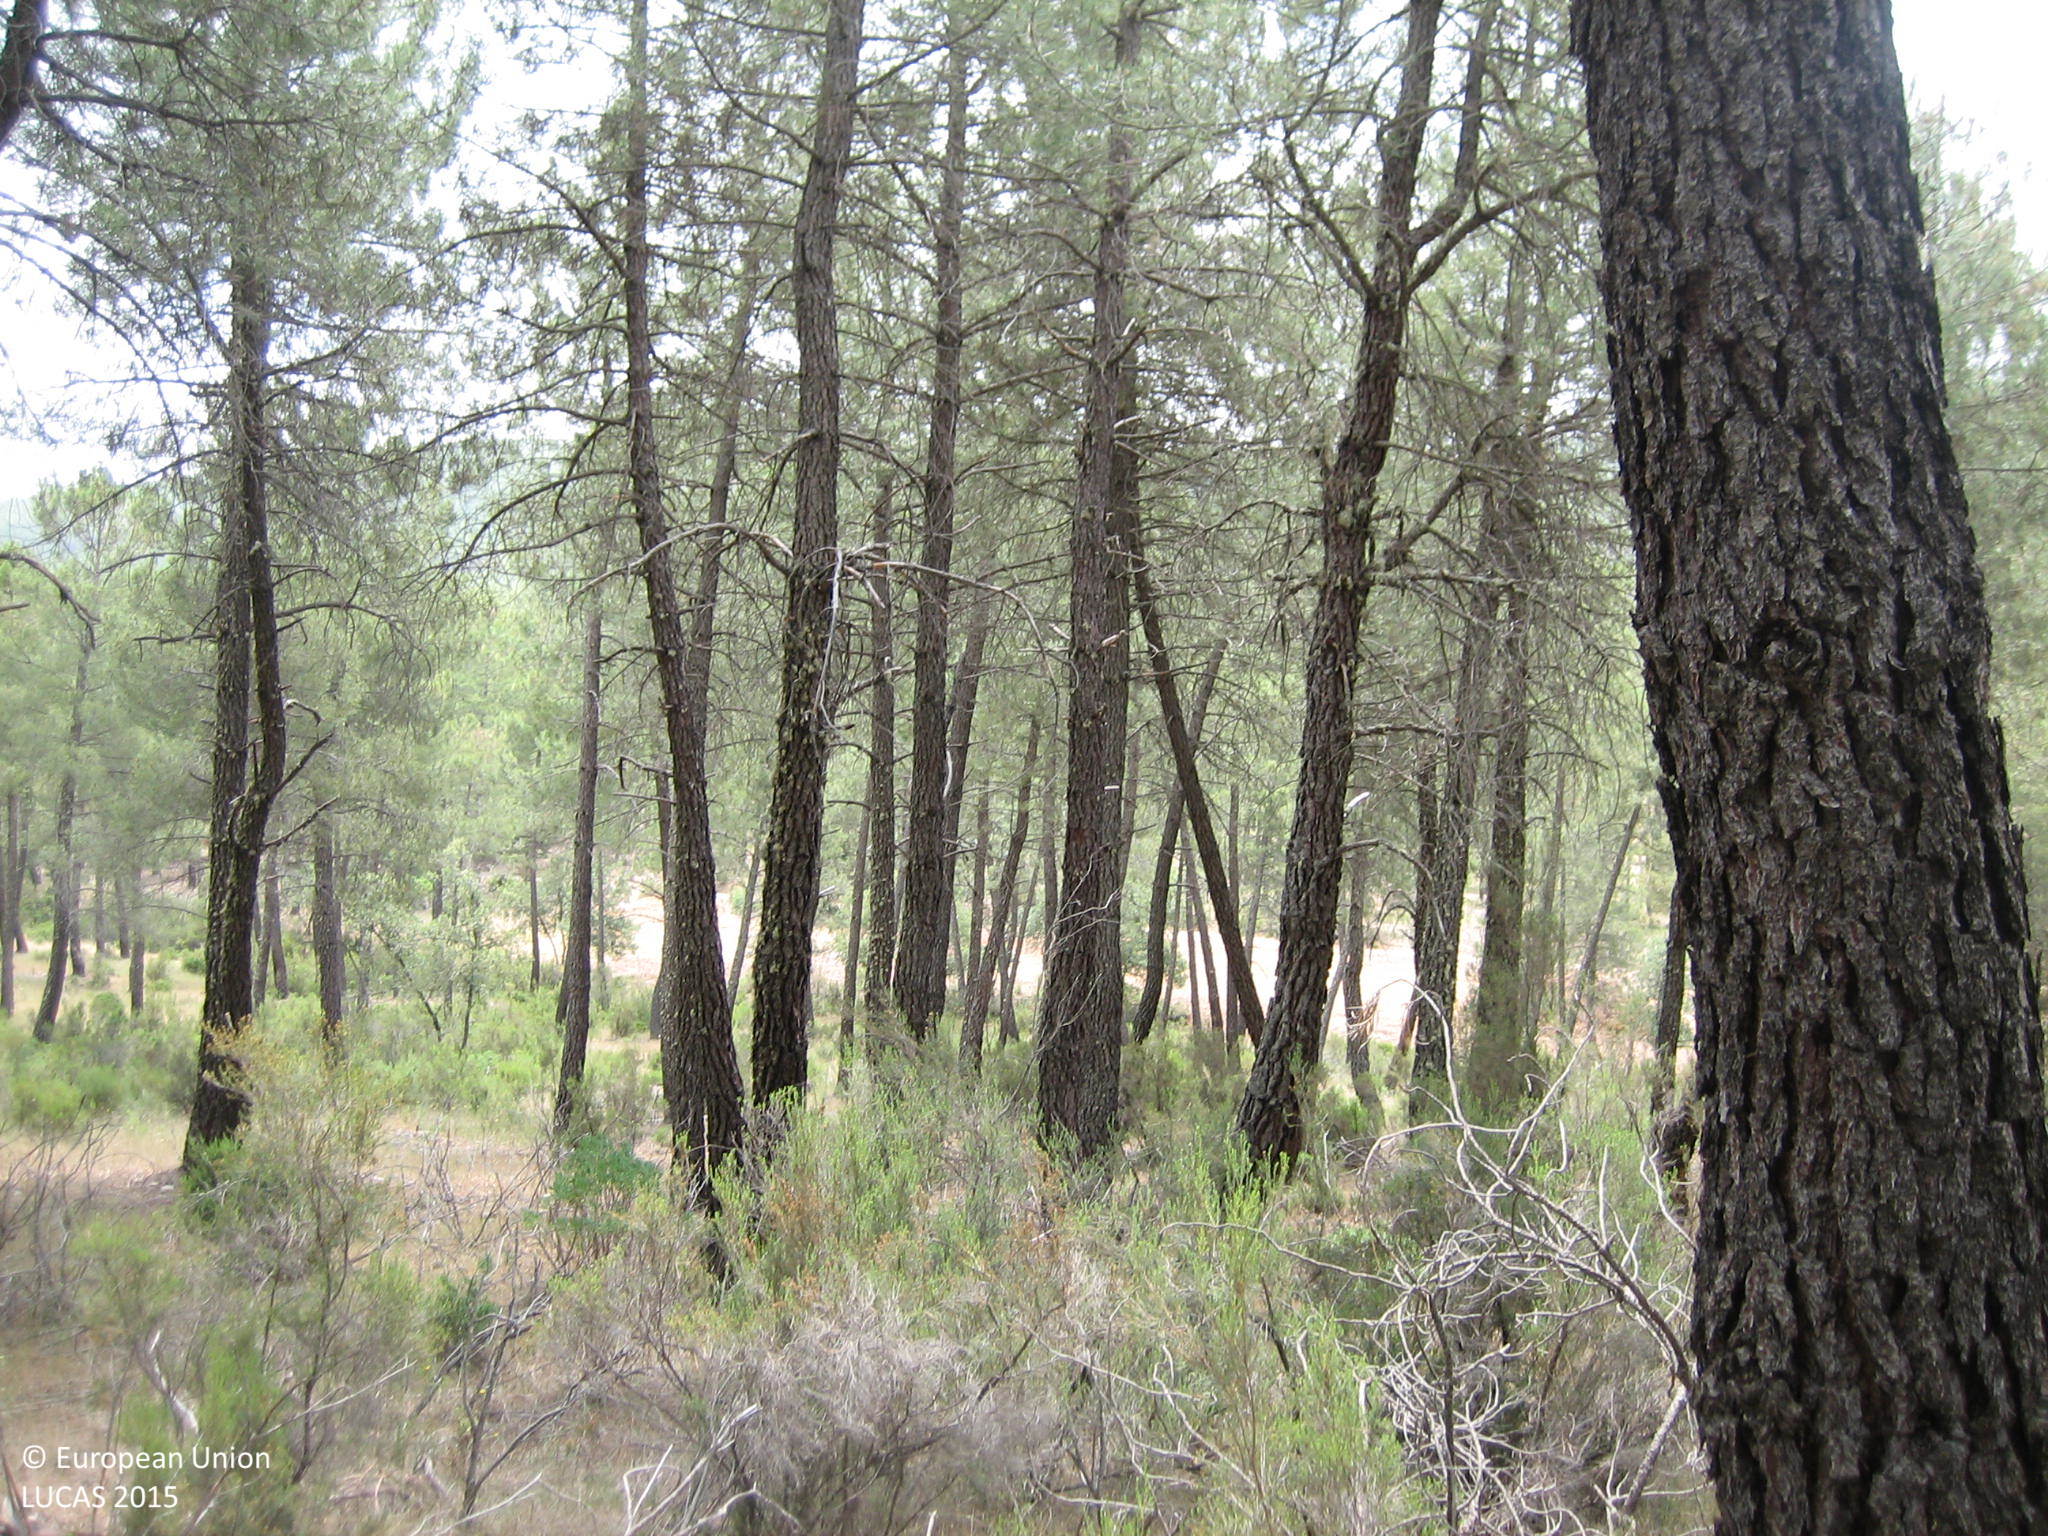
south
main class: Woodland
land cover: Pine dominated coniferous woodland
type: alpine coniferous forest
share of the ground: > 75 %
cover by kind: coniferous forest trees 85 %, herbaceous plants 10 %, shrubs 5 %
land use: Forestry
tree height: > 5 m
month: June
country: ES
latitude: 39.1107
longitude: -4.4974
